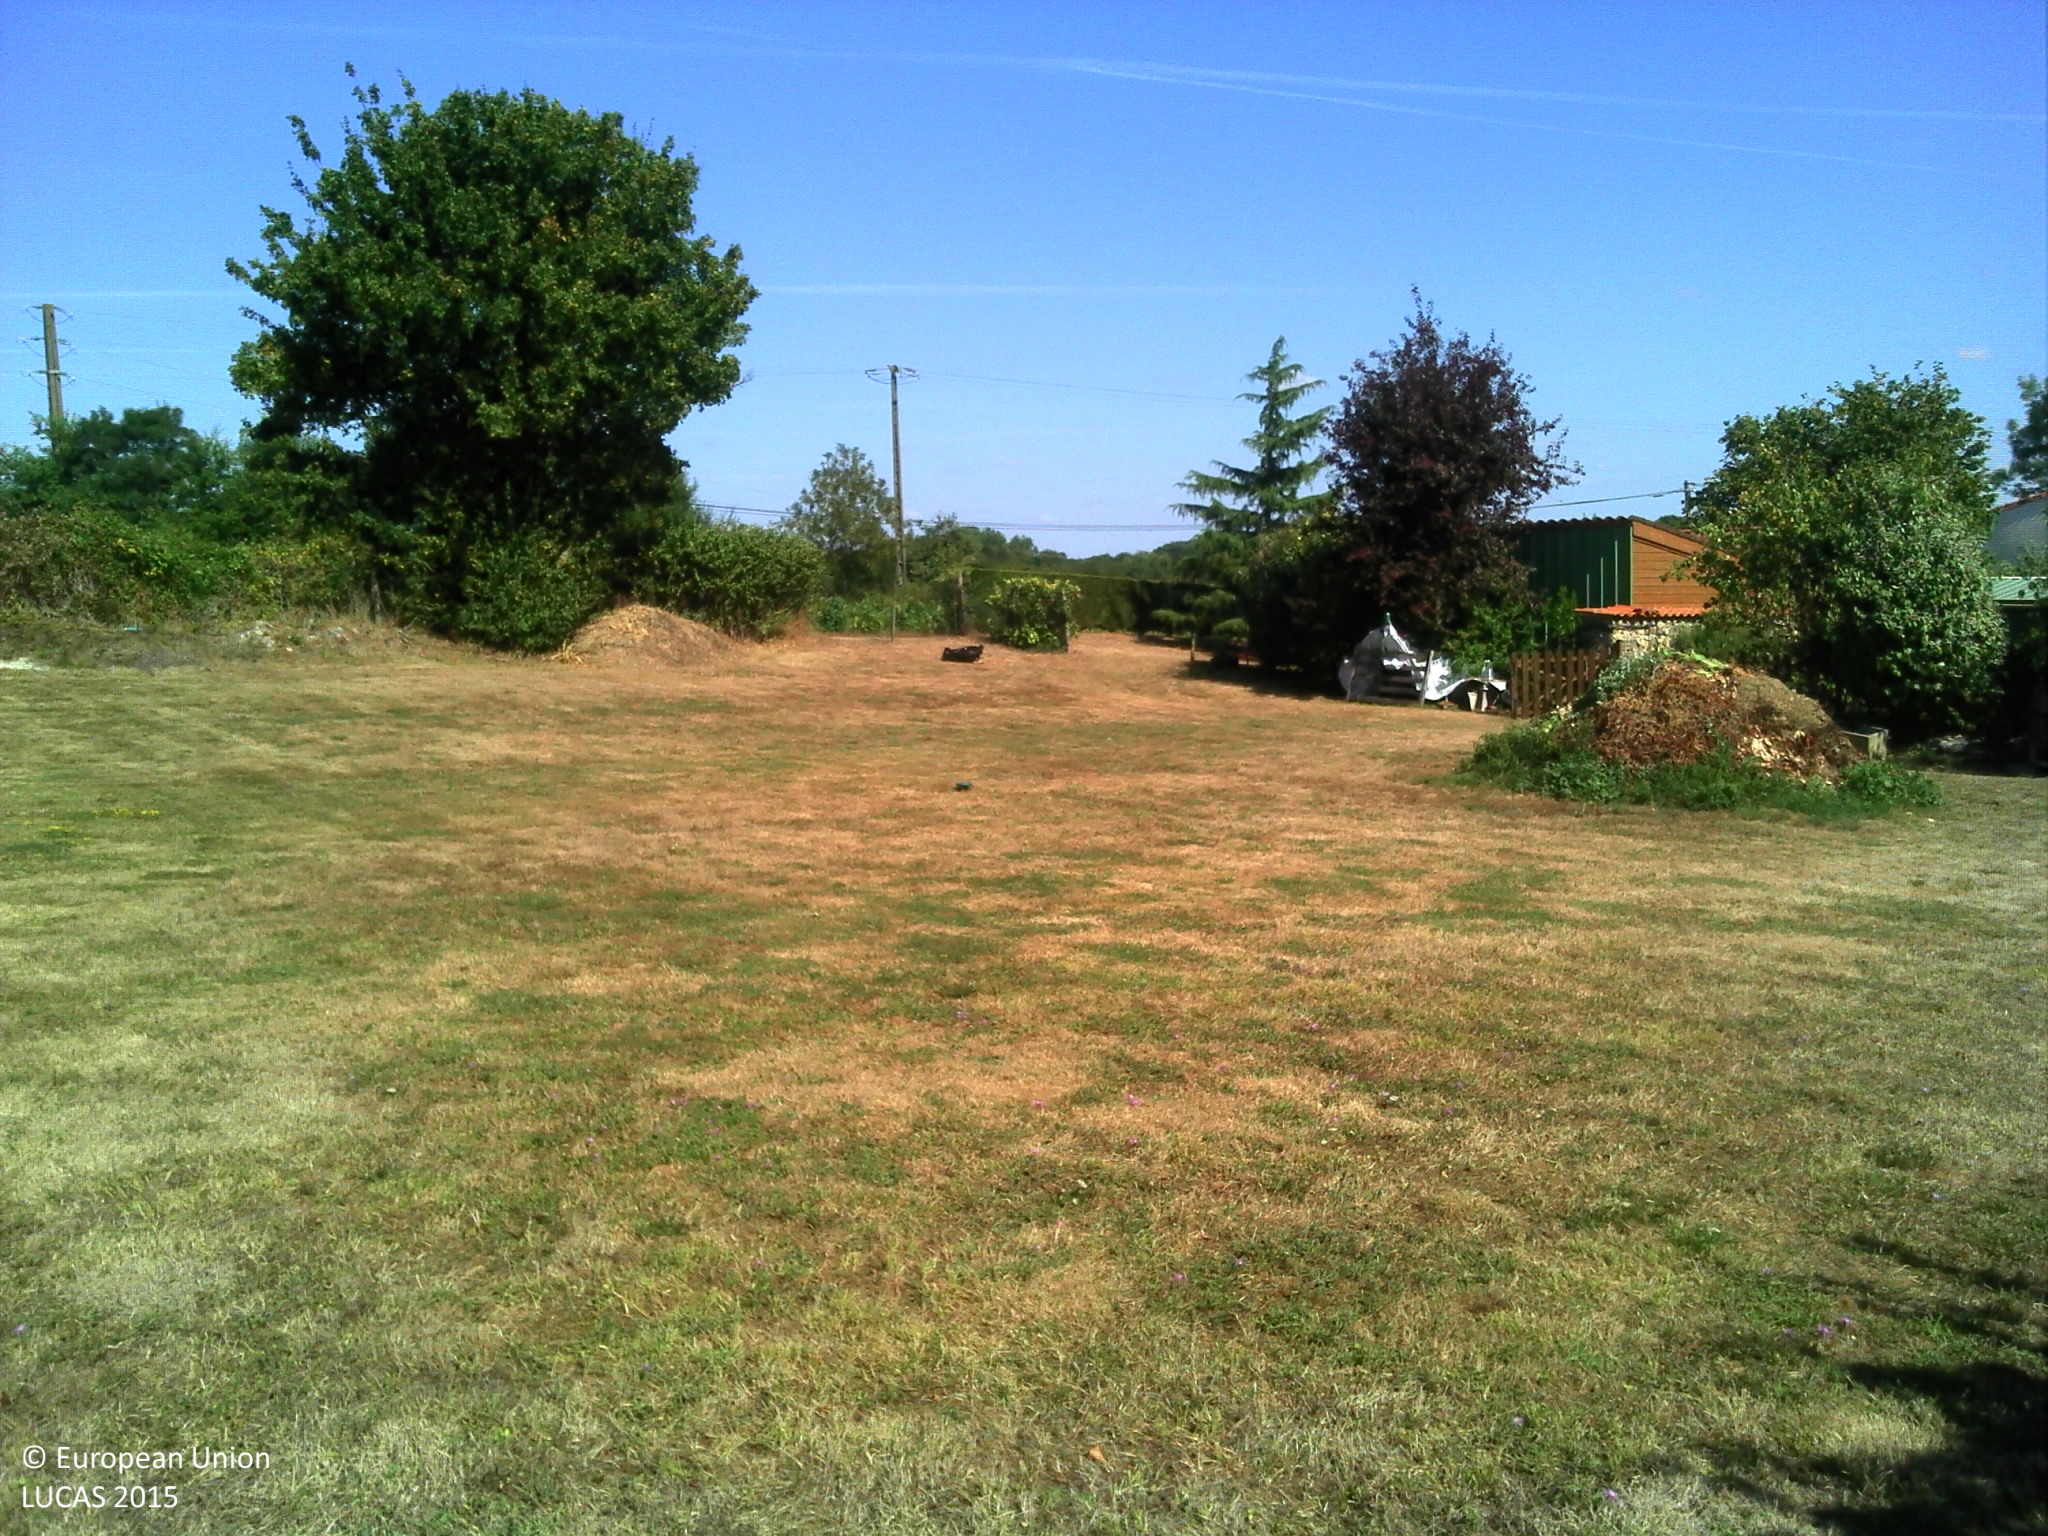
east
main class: Grassland
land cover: Grassland with sparse tree/shrub cover
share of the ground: > 75 %
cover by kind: herbaceous plants 90 %, broadleaved forest trees 5 %, shrubs 5 %
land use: Residential
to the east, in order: Grassland with sparse tree/shrub cover; Single bushes/trees; Managed hedges; Tracks; Vineyards; Grassland without tree/shrub cover; Electric lines; Abandoned hedges; Ditches and canals; Grass margins; Paved roads, cycling and walking lanes; Grass margins; Ditches and canals; Electric lines; Abandoned hedges; Other cereals; Electric lines; Other cereals
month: August
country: FR
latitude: 46.7532
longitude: -1.0962
